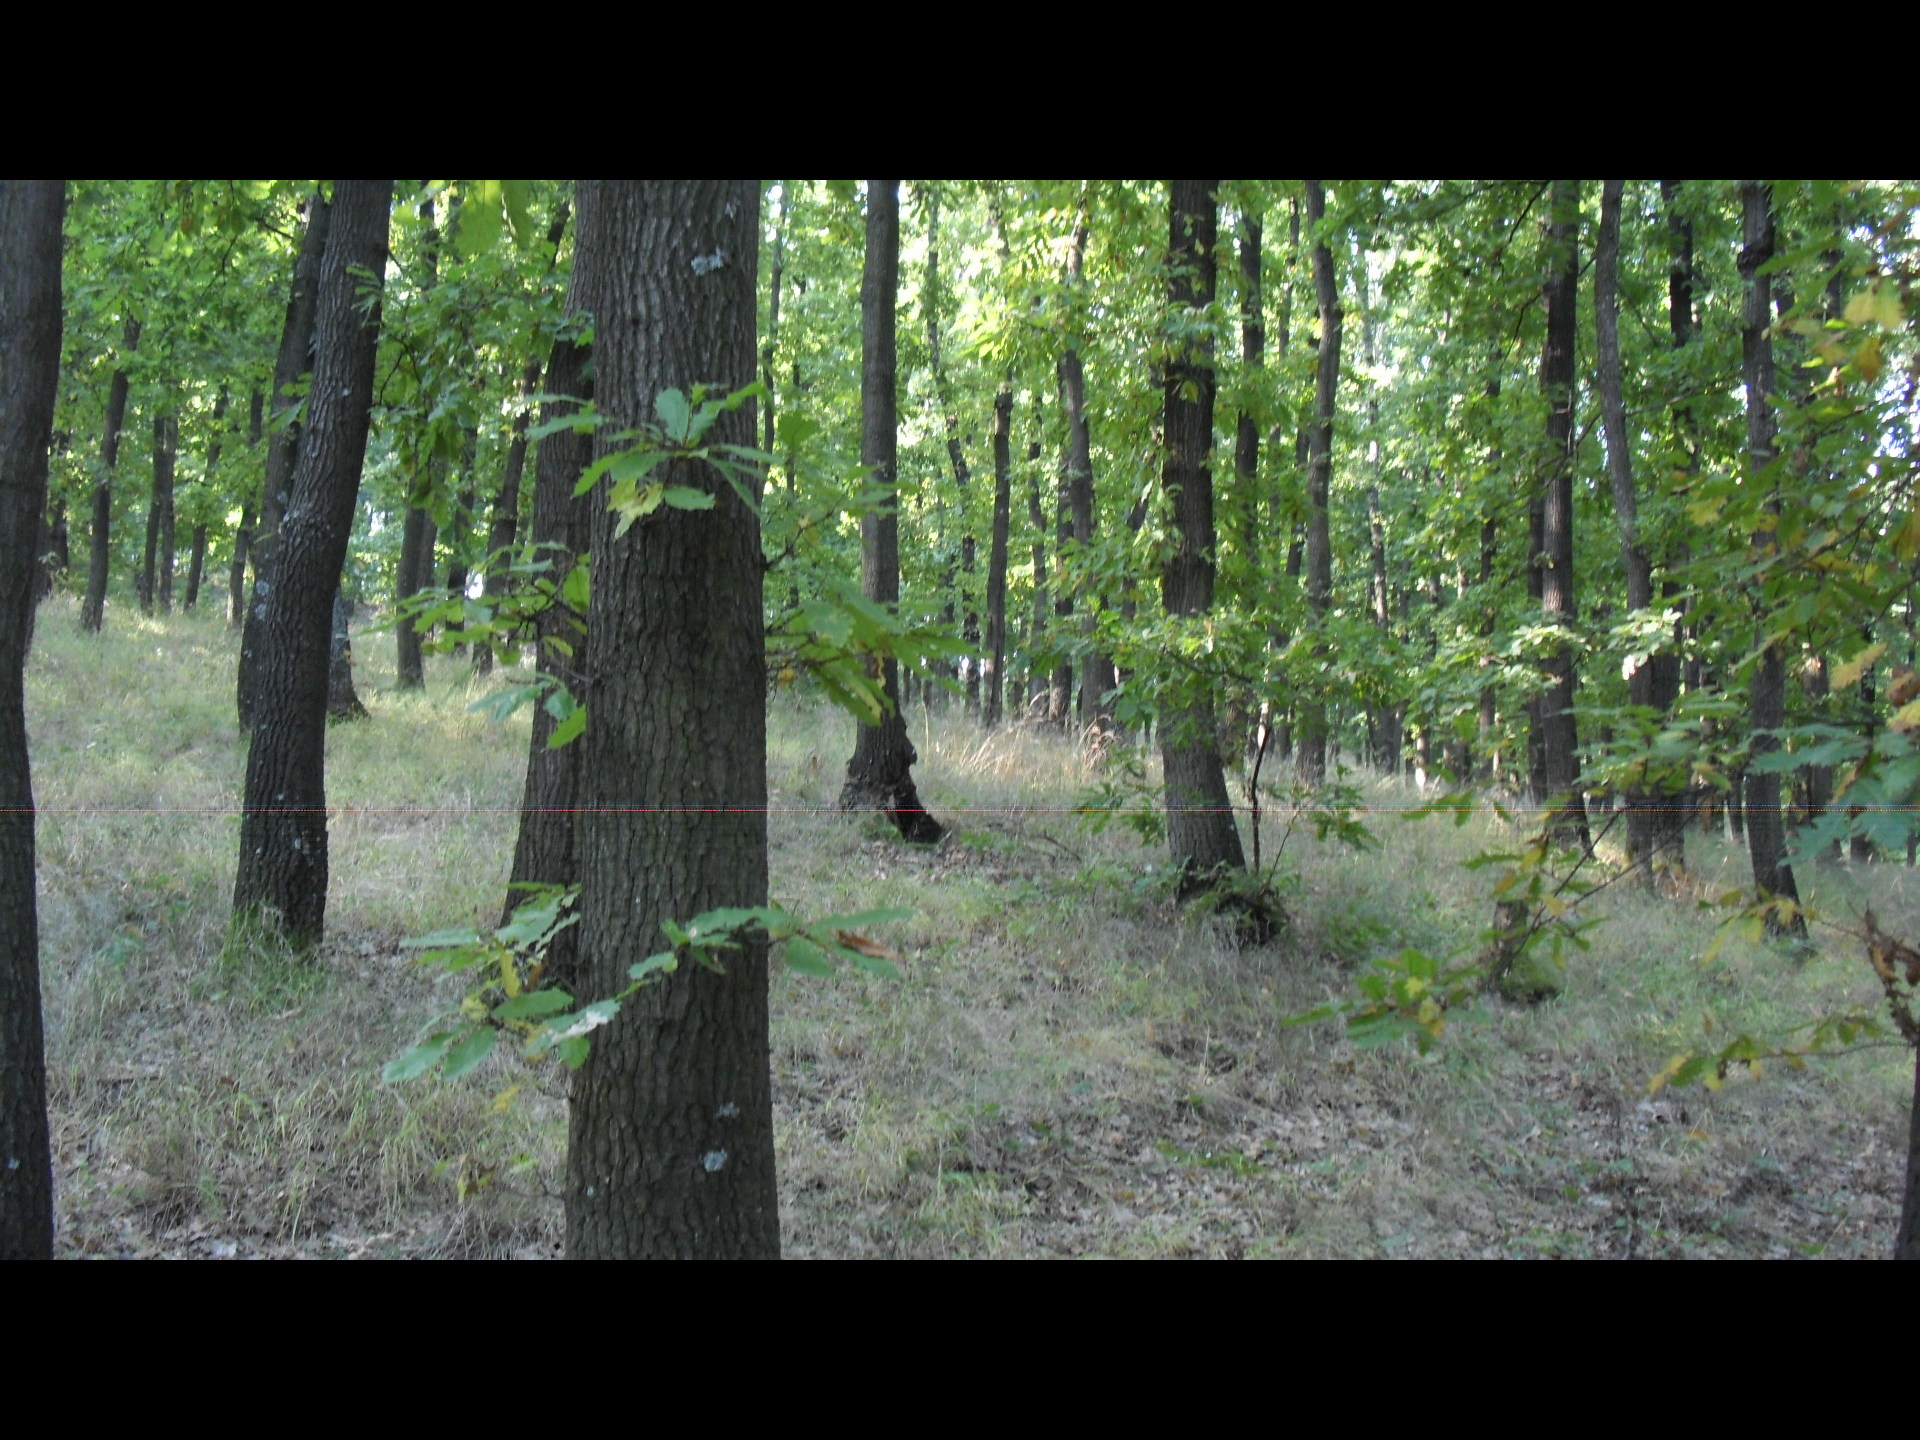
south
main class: Woodland
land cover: Broadleaved woodland
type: mesophytic deciduous forest
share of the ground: > 75 %
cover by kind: broadleaved forest trees 85 %, herbaceous plants 15 %
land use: Forestry
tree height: > 5 m
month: September
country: BG
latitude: 44.0496
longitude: 22.6302
